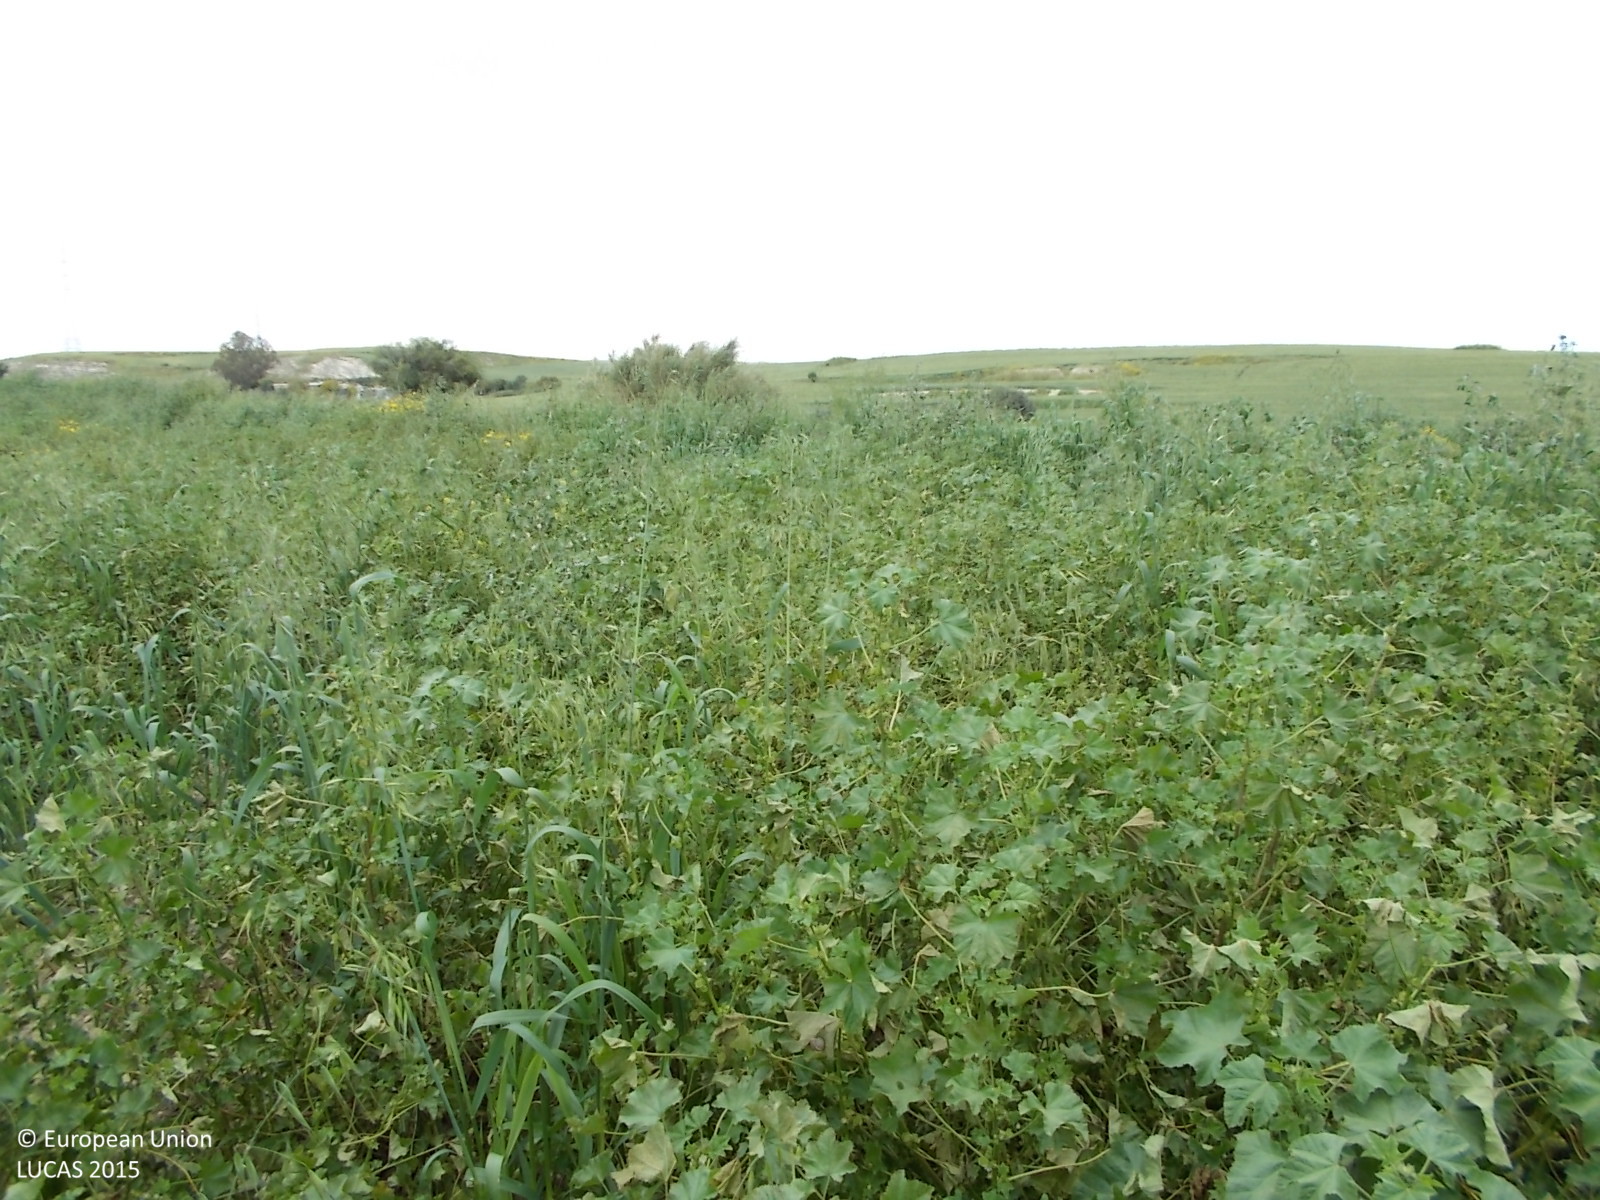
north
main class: Cropland
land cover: Other fresh vegetables
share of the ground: > 75 %
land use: Agriculture (excluding fallow land and kitchen gardens)
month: April
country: CY
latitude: 34.9115
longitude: 33.5609
